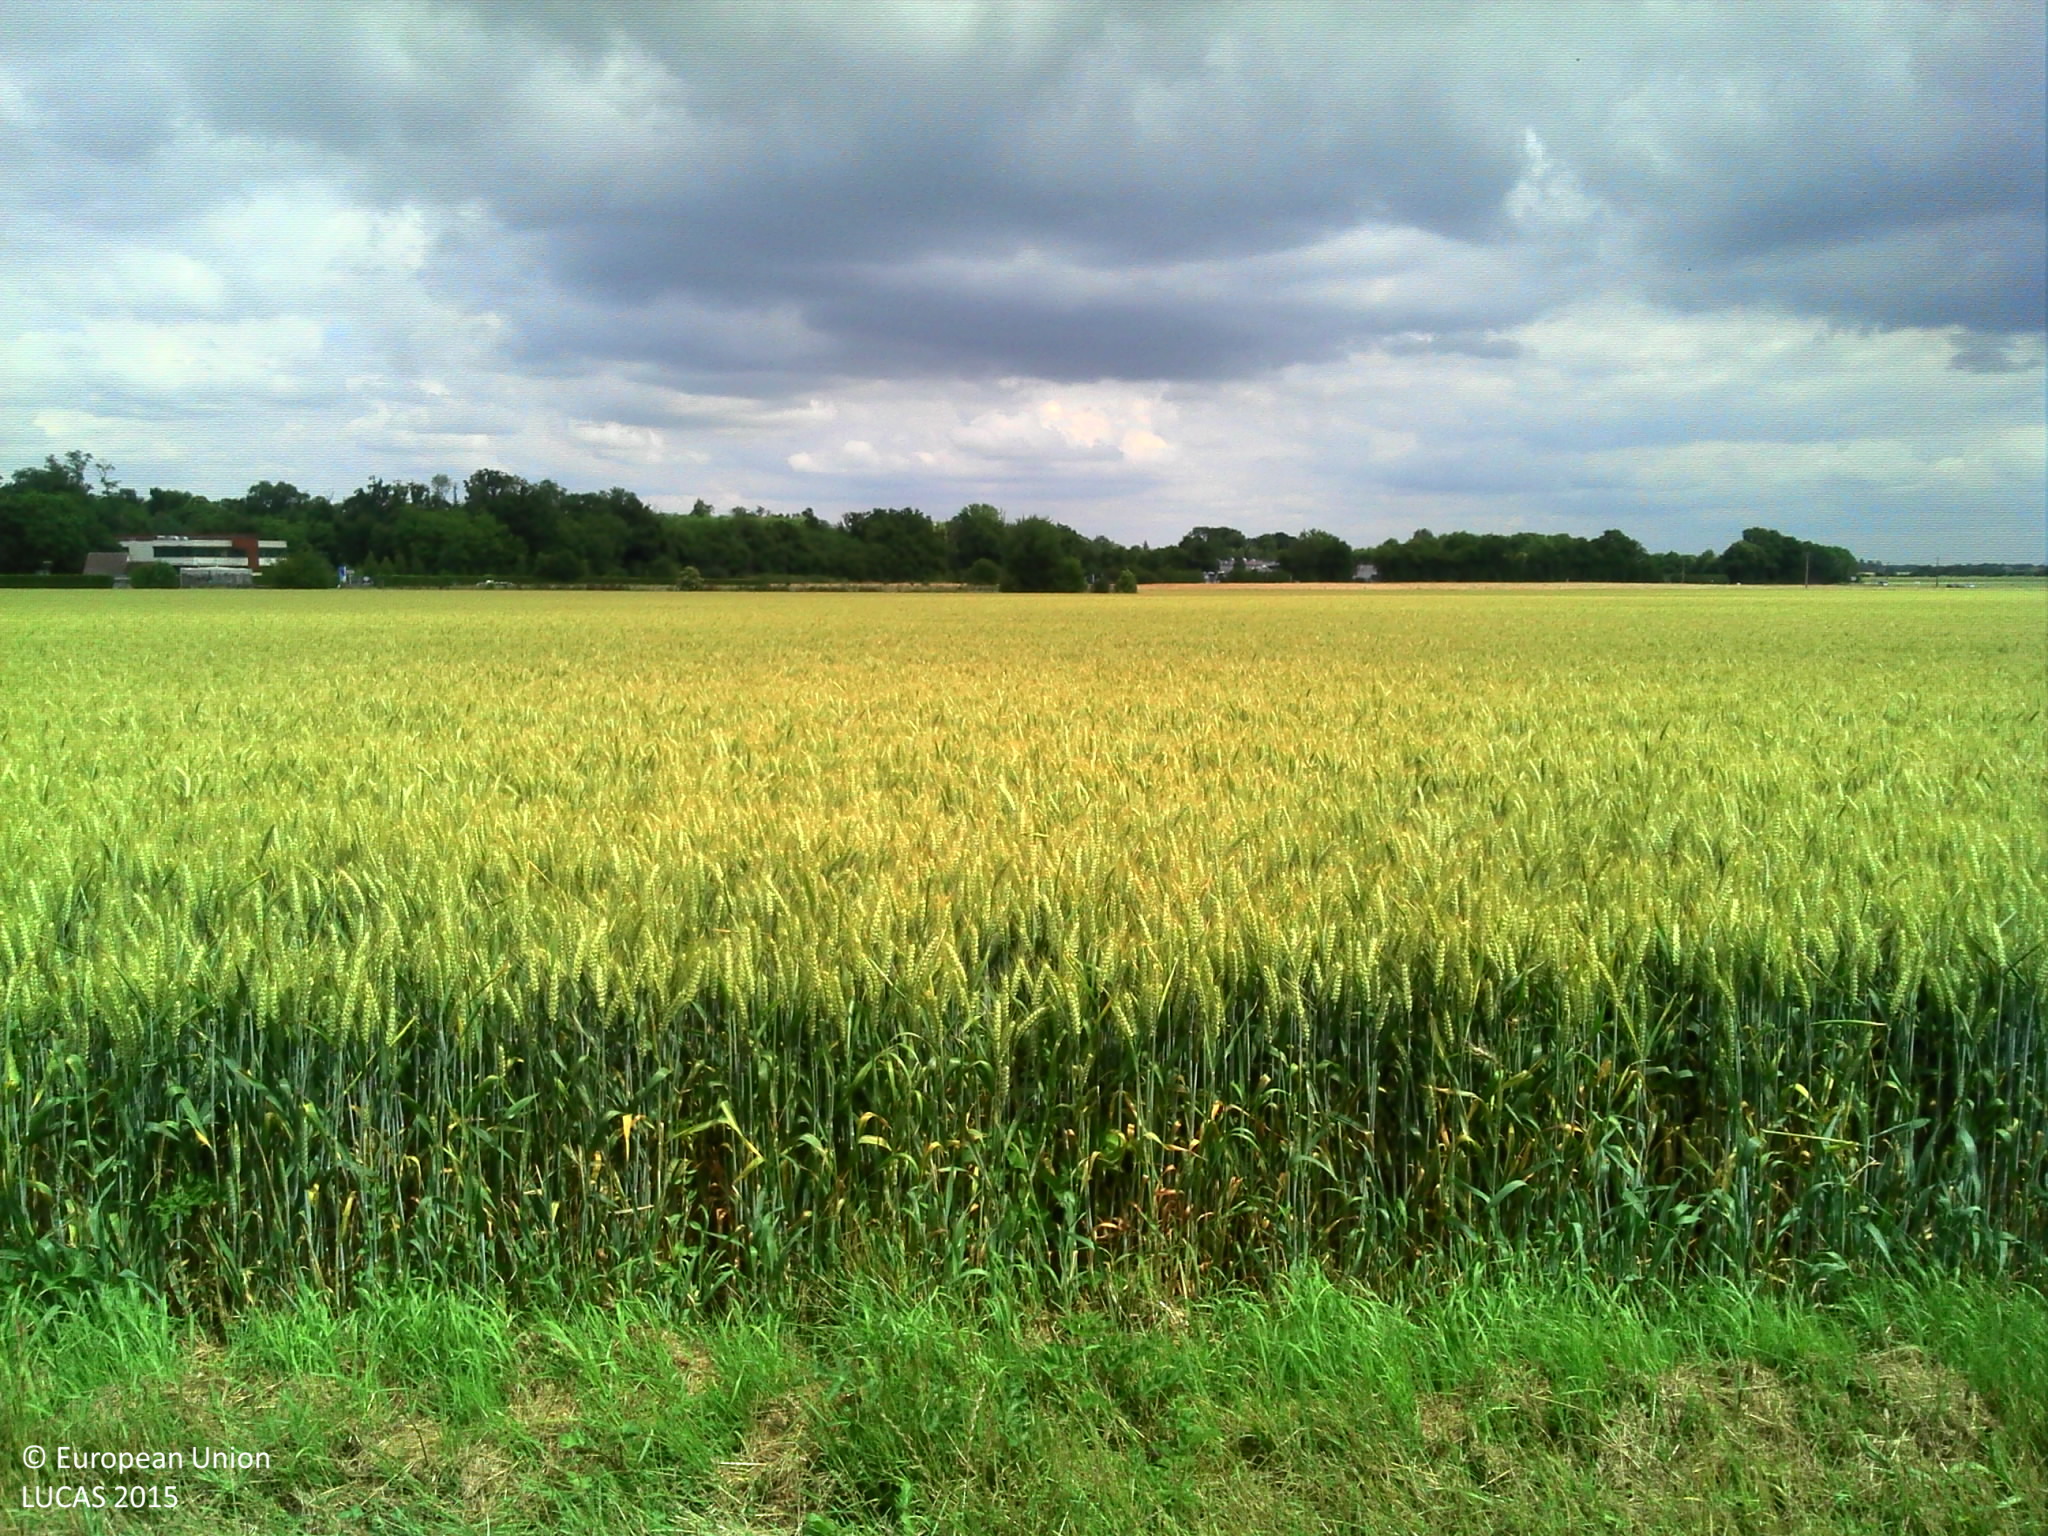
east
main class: Cropland
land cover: Rape and turnip rape
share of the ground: > 75 %
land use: Agriculture (excluding fallow land and kitchen gardens)
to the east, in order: Rape and turnip rape; Grass margins; Tracks; Grass margins; Electric lines; Common wheat
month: June
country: FR
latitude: 49.0168
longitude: 1.2705
